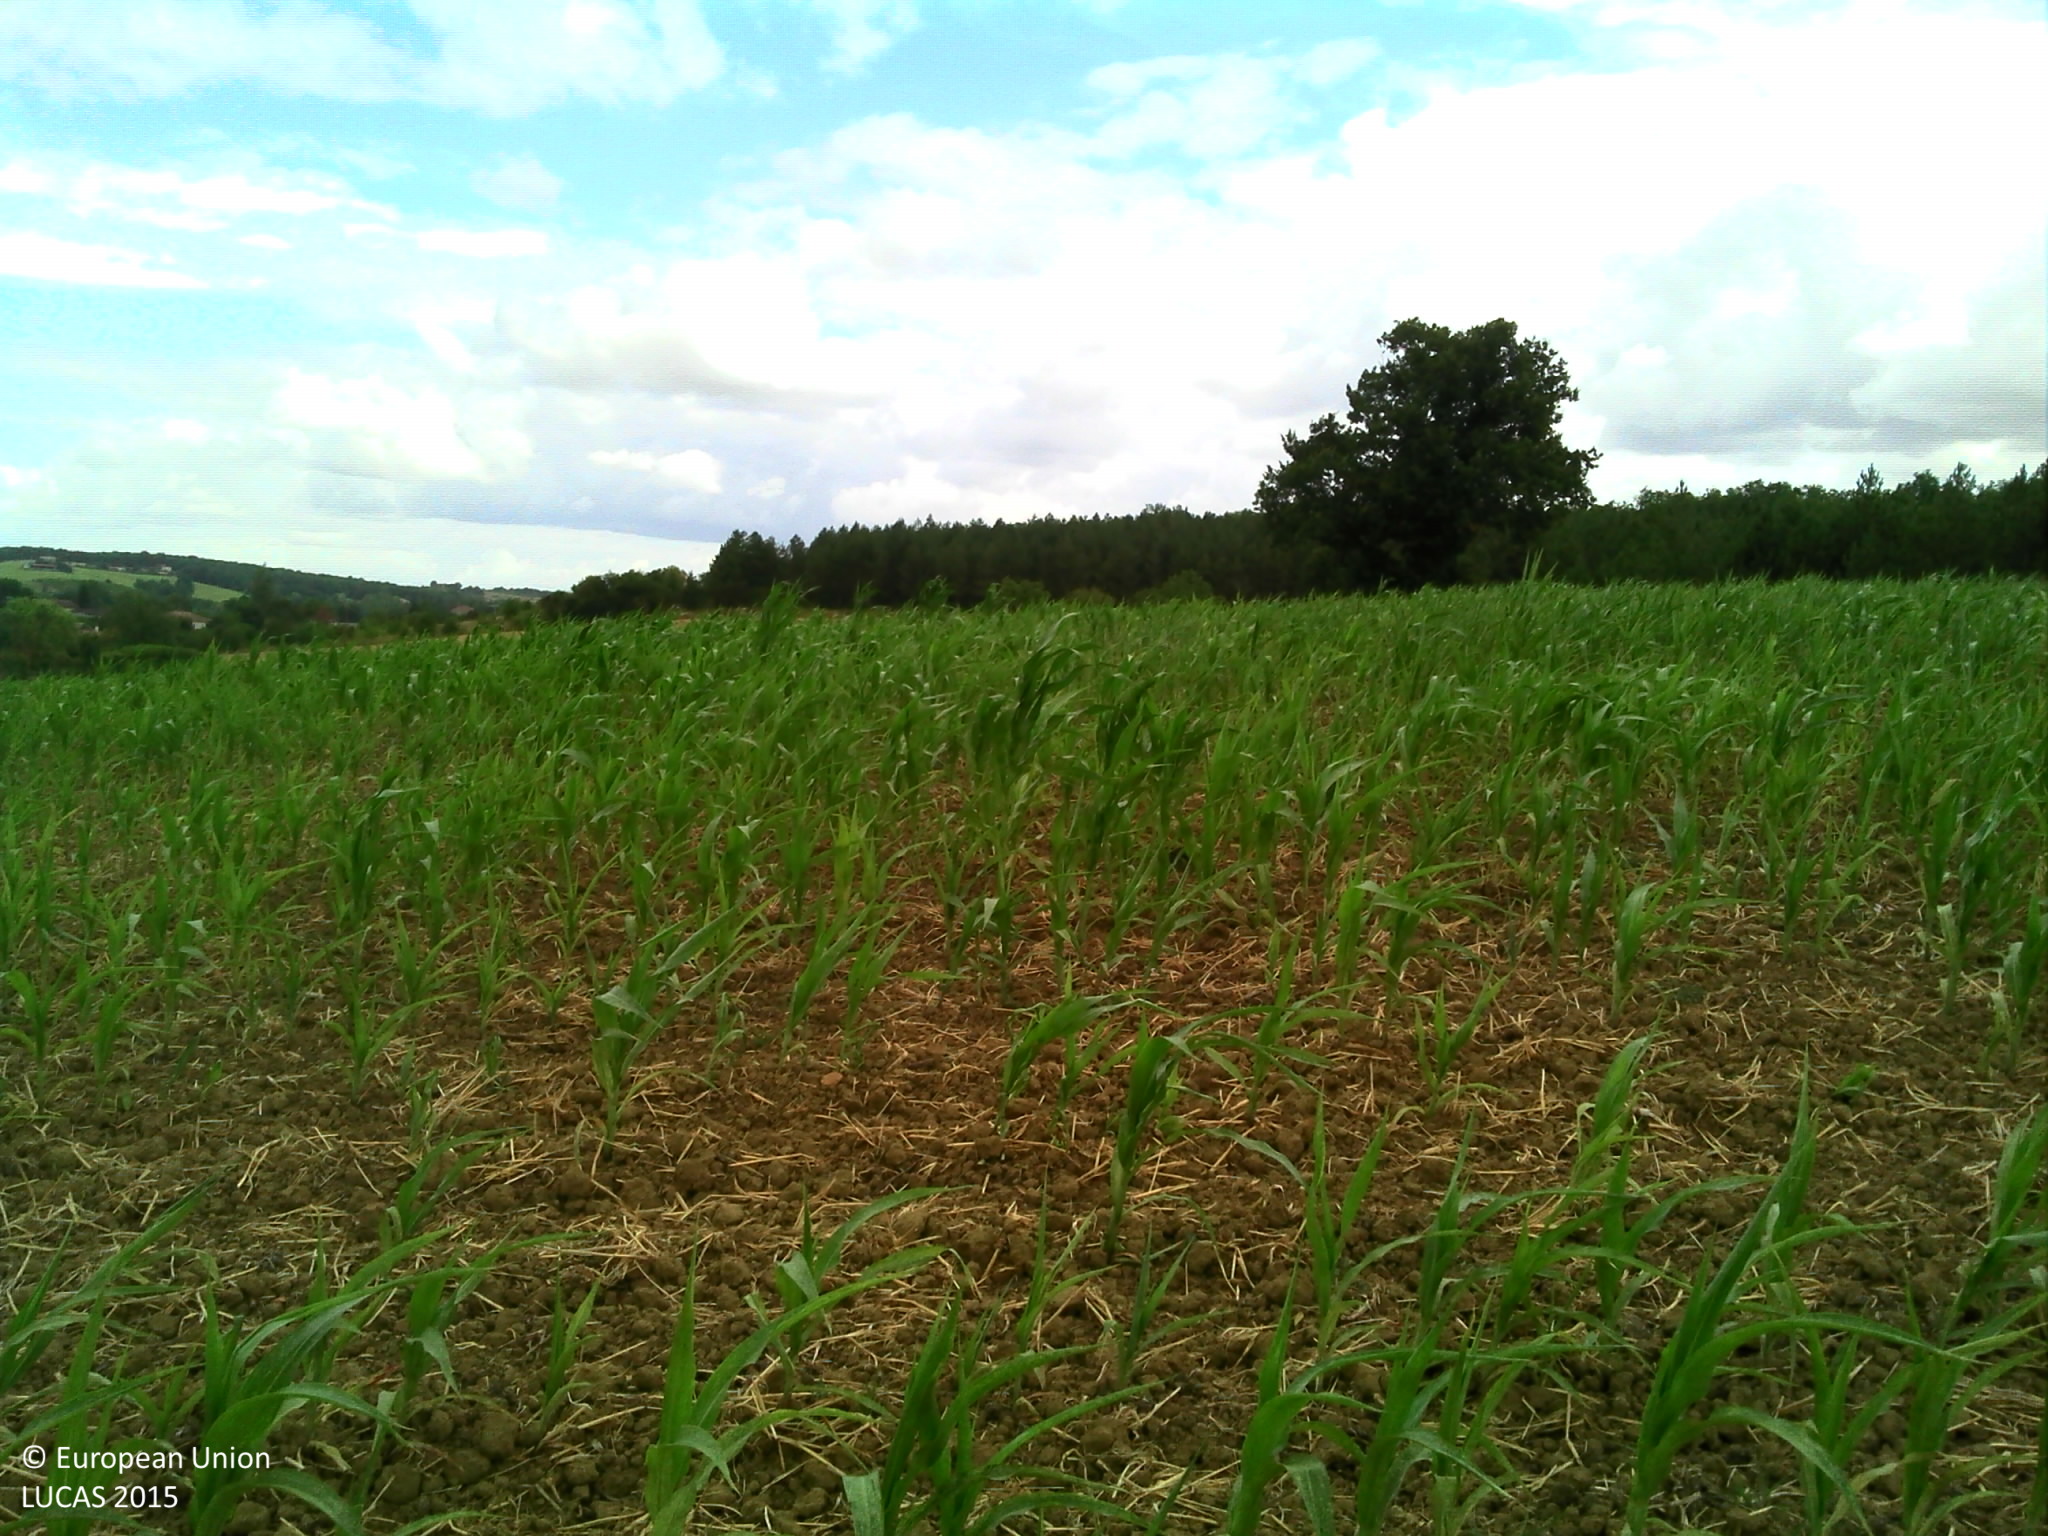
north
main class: Cropland
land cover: Maize
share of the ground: 10 - 25 %
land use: Agriculture (excluding fallow land and kitchen gardens)
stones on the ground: < 10 %
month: July
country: FR
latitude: 44.4632
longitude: 0.5534
